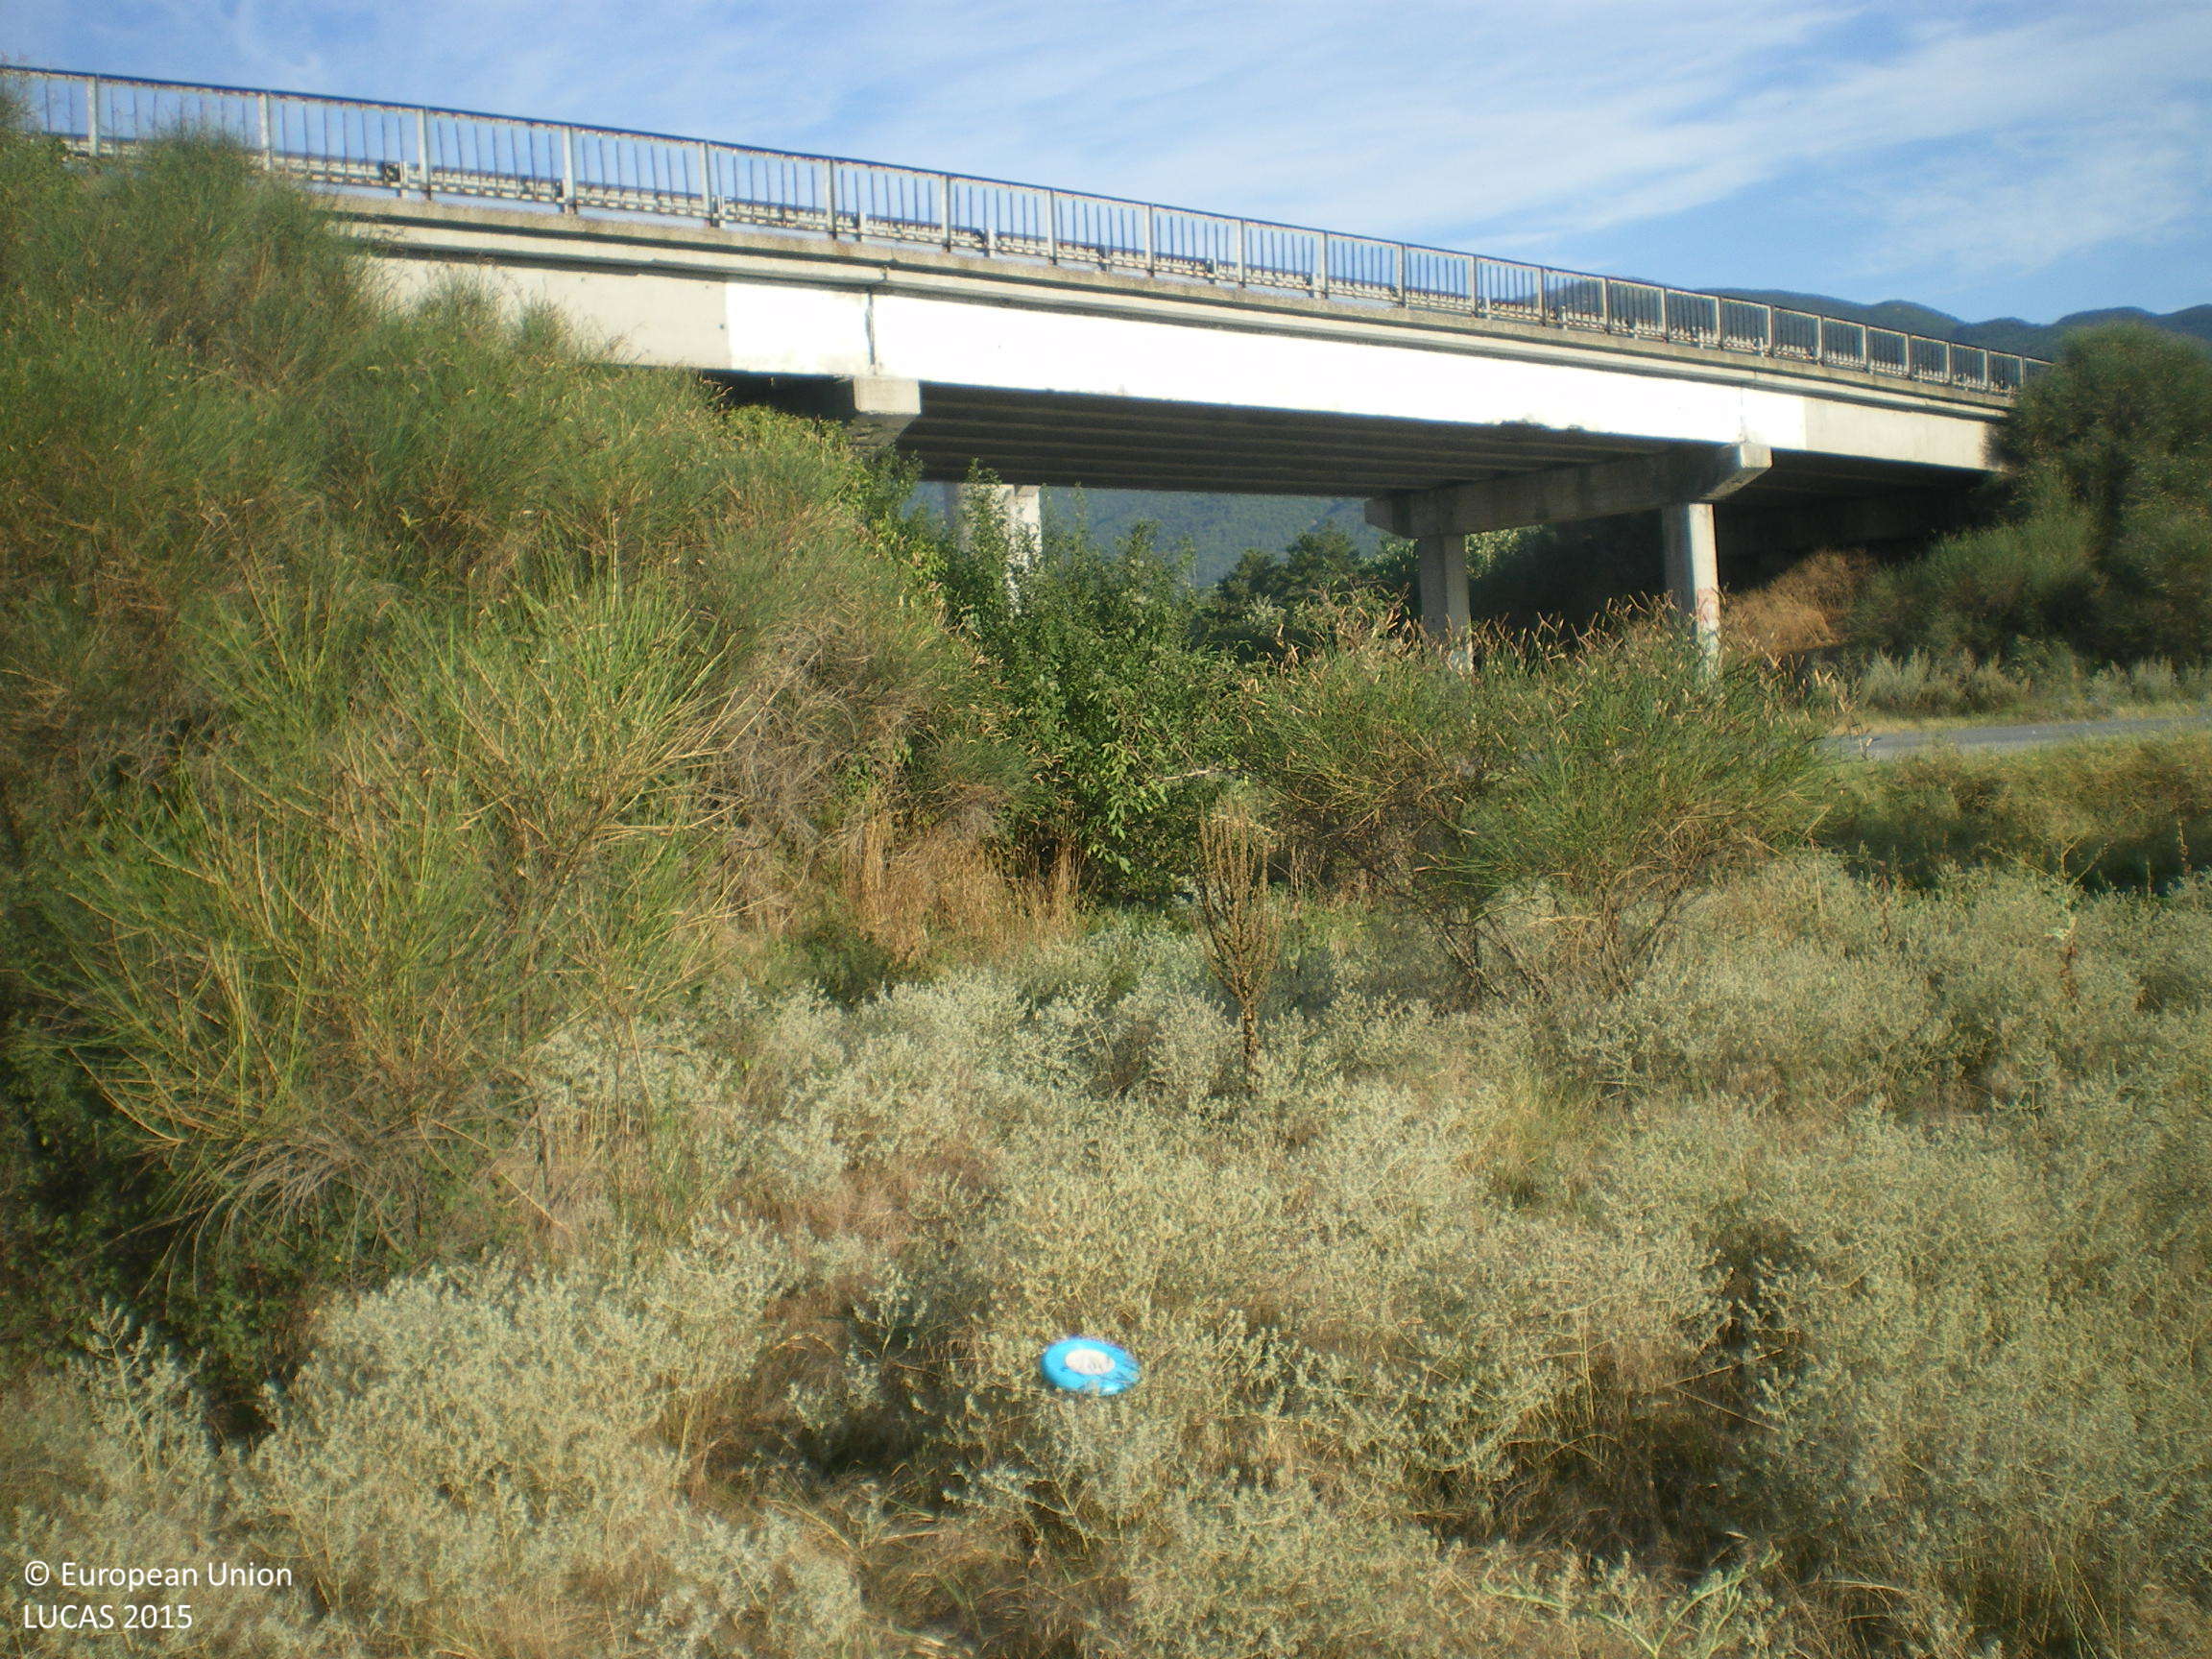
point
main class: Grassland
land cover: Grassland without tree/shrub cover
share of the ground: > 75 %
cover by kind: herbaceous plants 95 %, shrubs 5 %
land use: Road transport
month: August
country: BG
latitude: 42.6053
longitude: 25.6397
